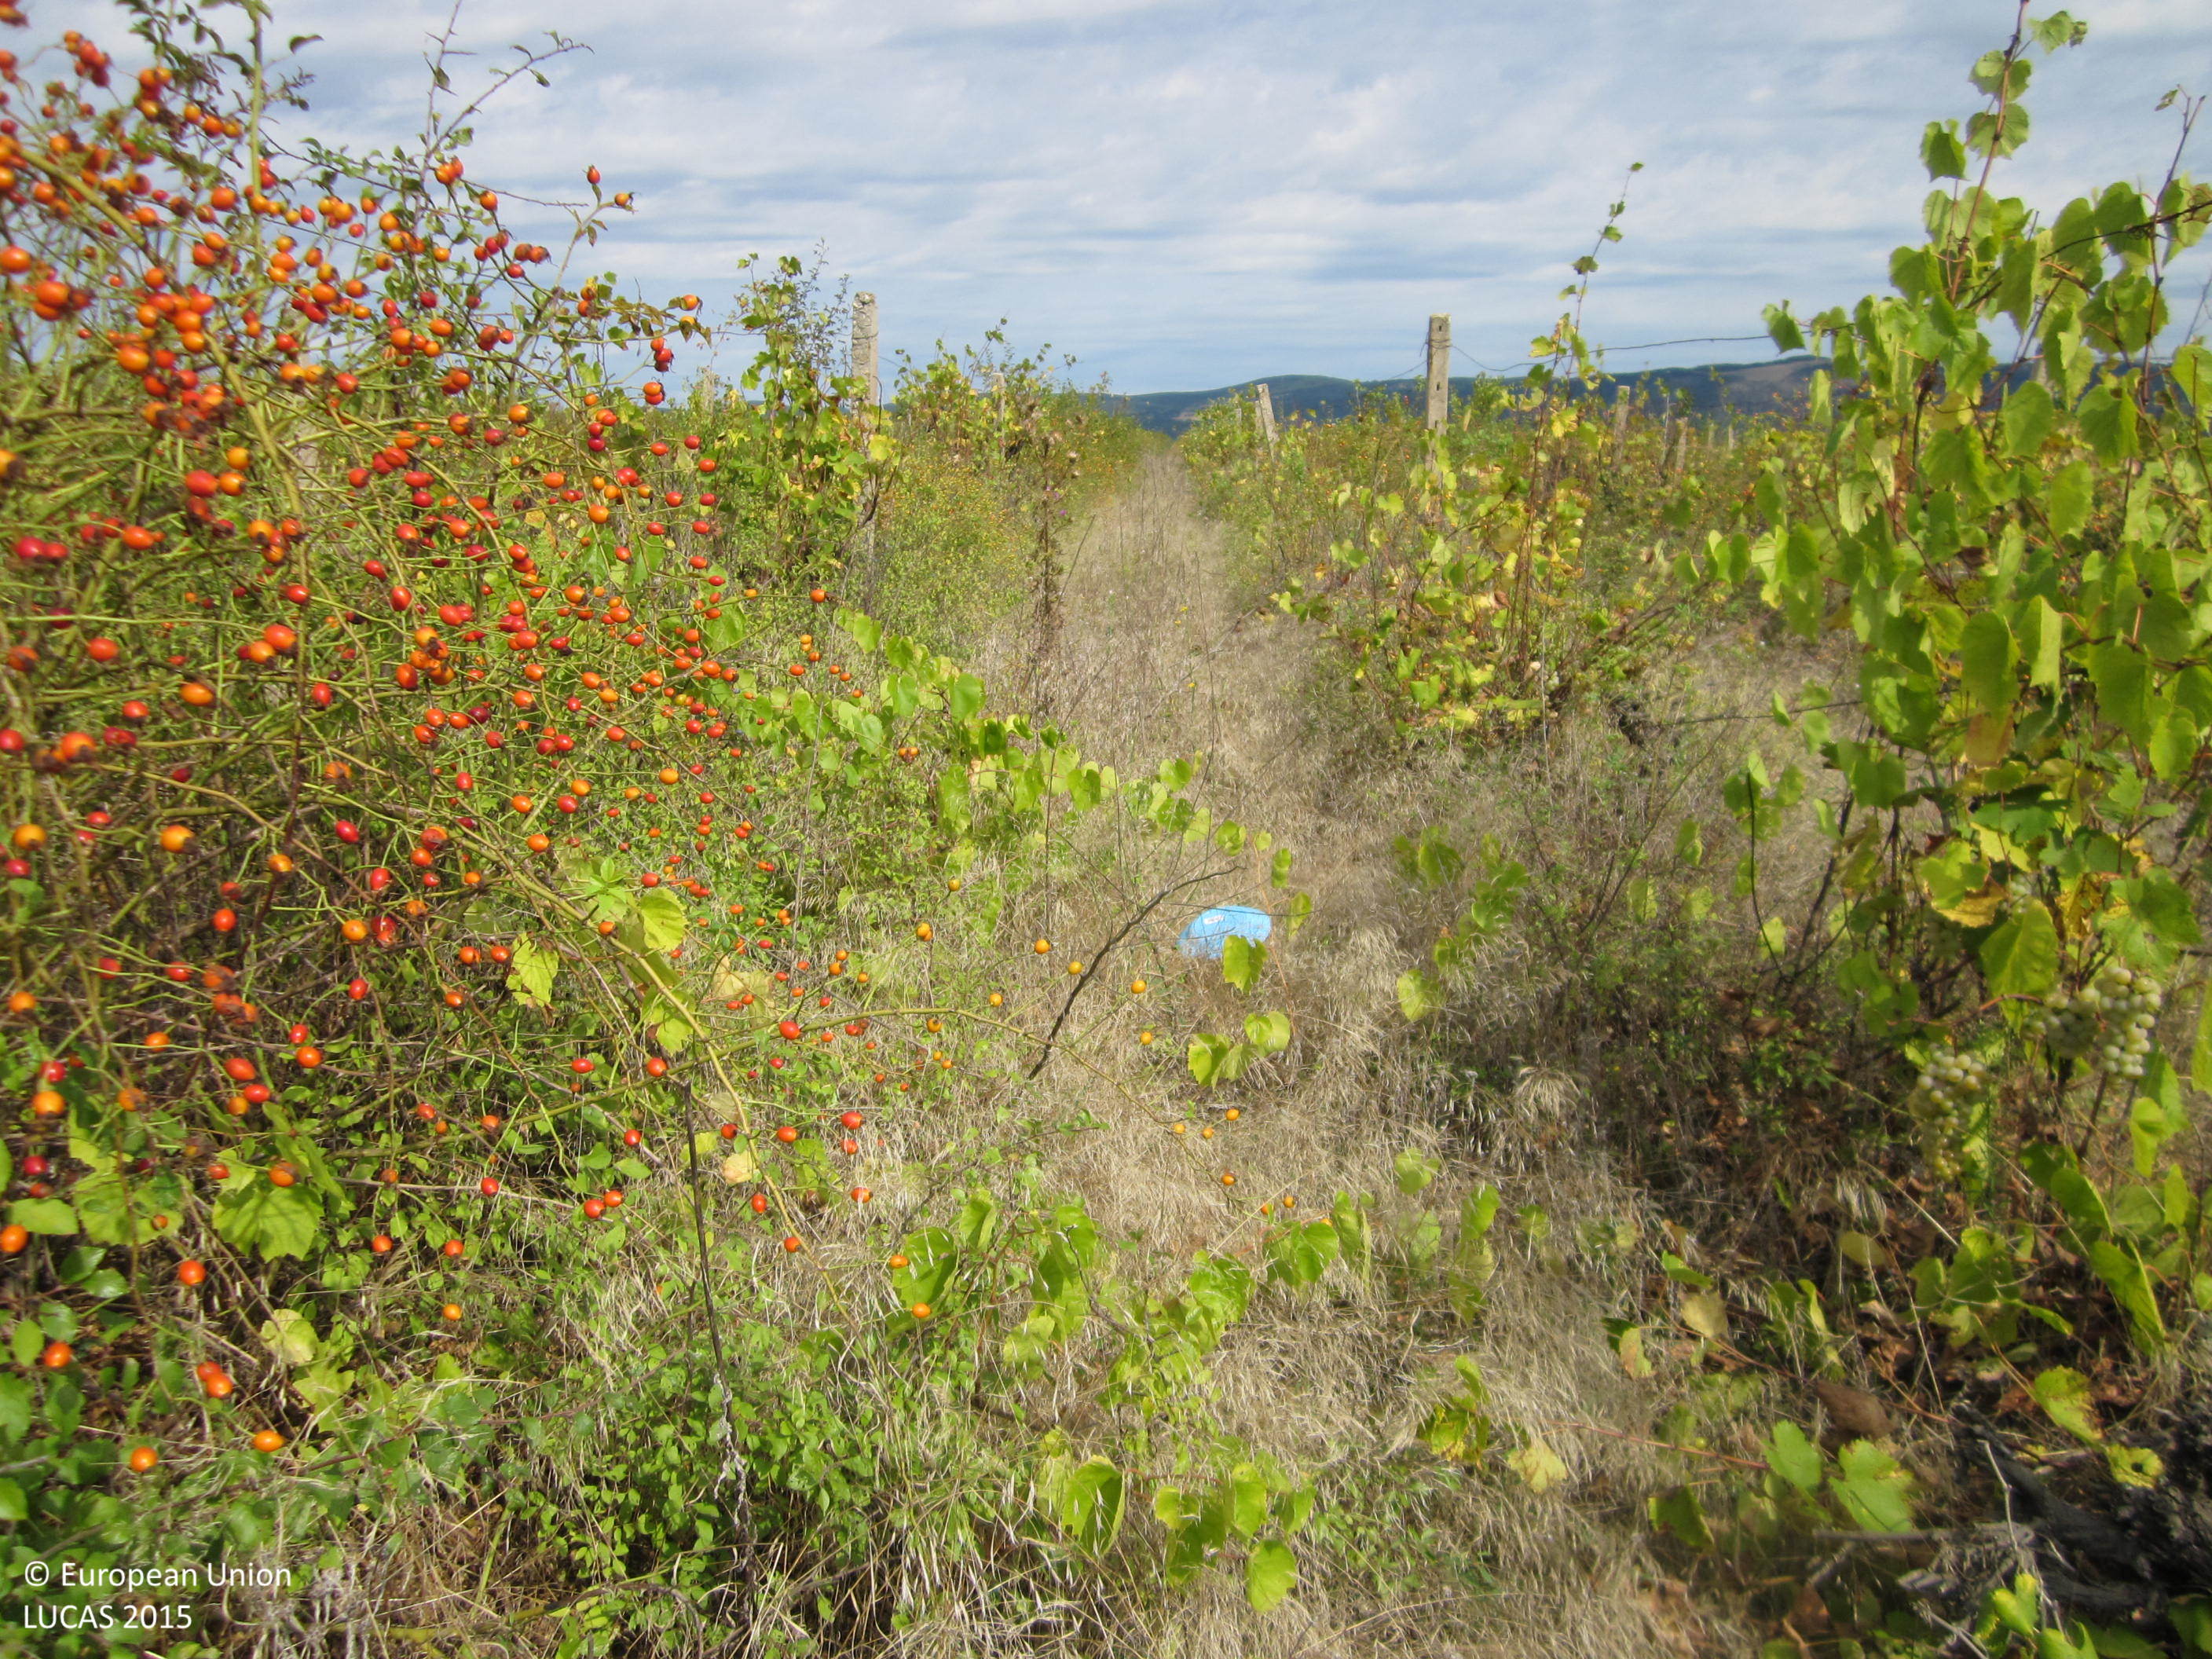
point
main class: Cropland
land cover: Vineyards
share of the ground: 50 - 75 %
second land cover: Spontaneously vegetated surfaces
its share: > 75 %
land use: Agriculture (excluding fallow land and kitchen gardens)
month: September
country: BG
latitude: 42.6908
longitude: 27.1377
